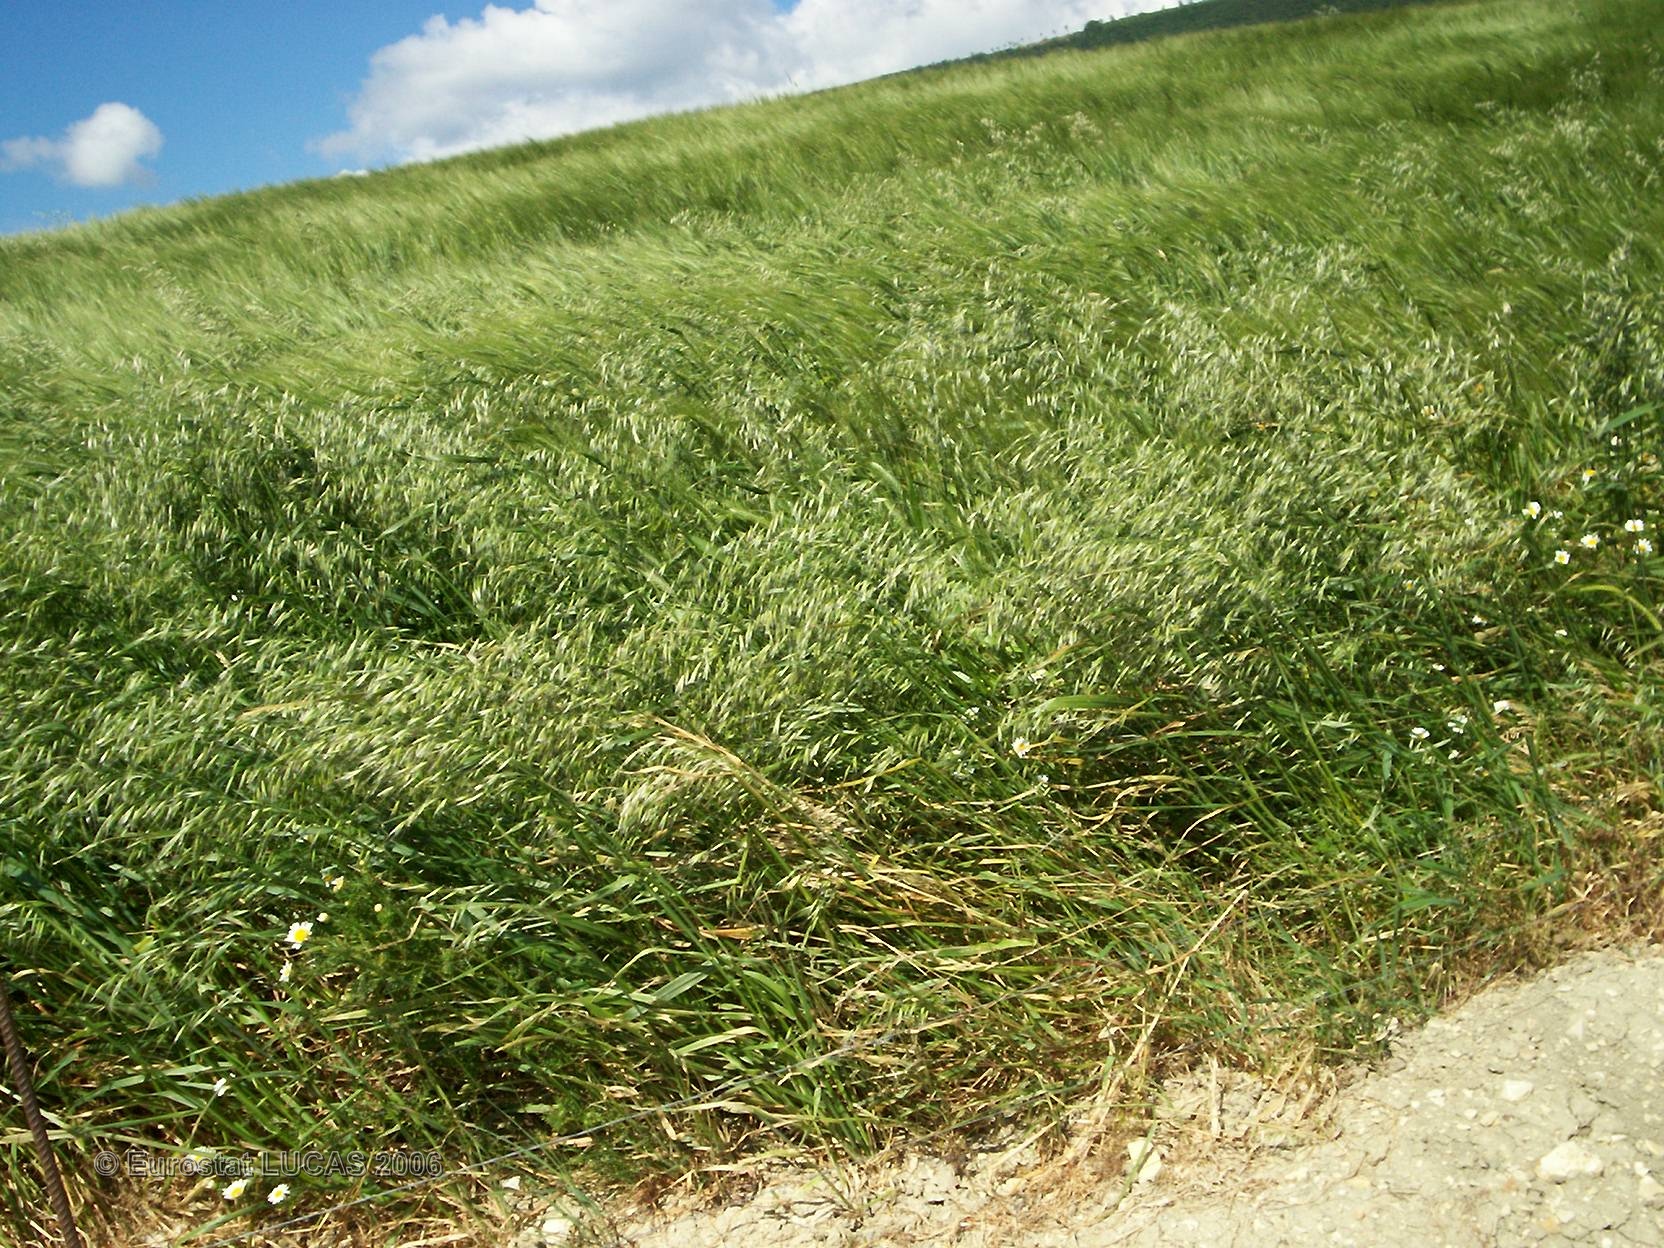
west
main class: Cropland
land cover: Maize
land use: Agriculture (excluding fallow land and kitchen gardens)
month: May
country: FR
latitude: 44.6587
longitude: 4.8989
